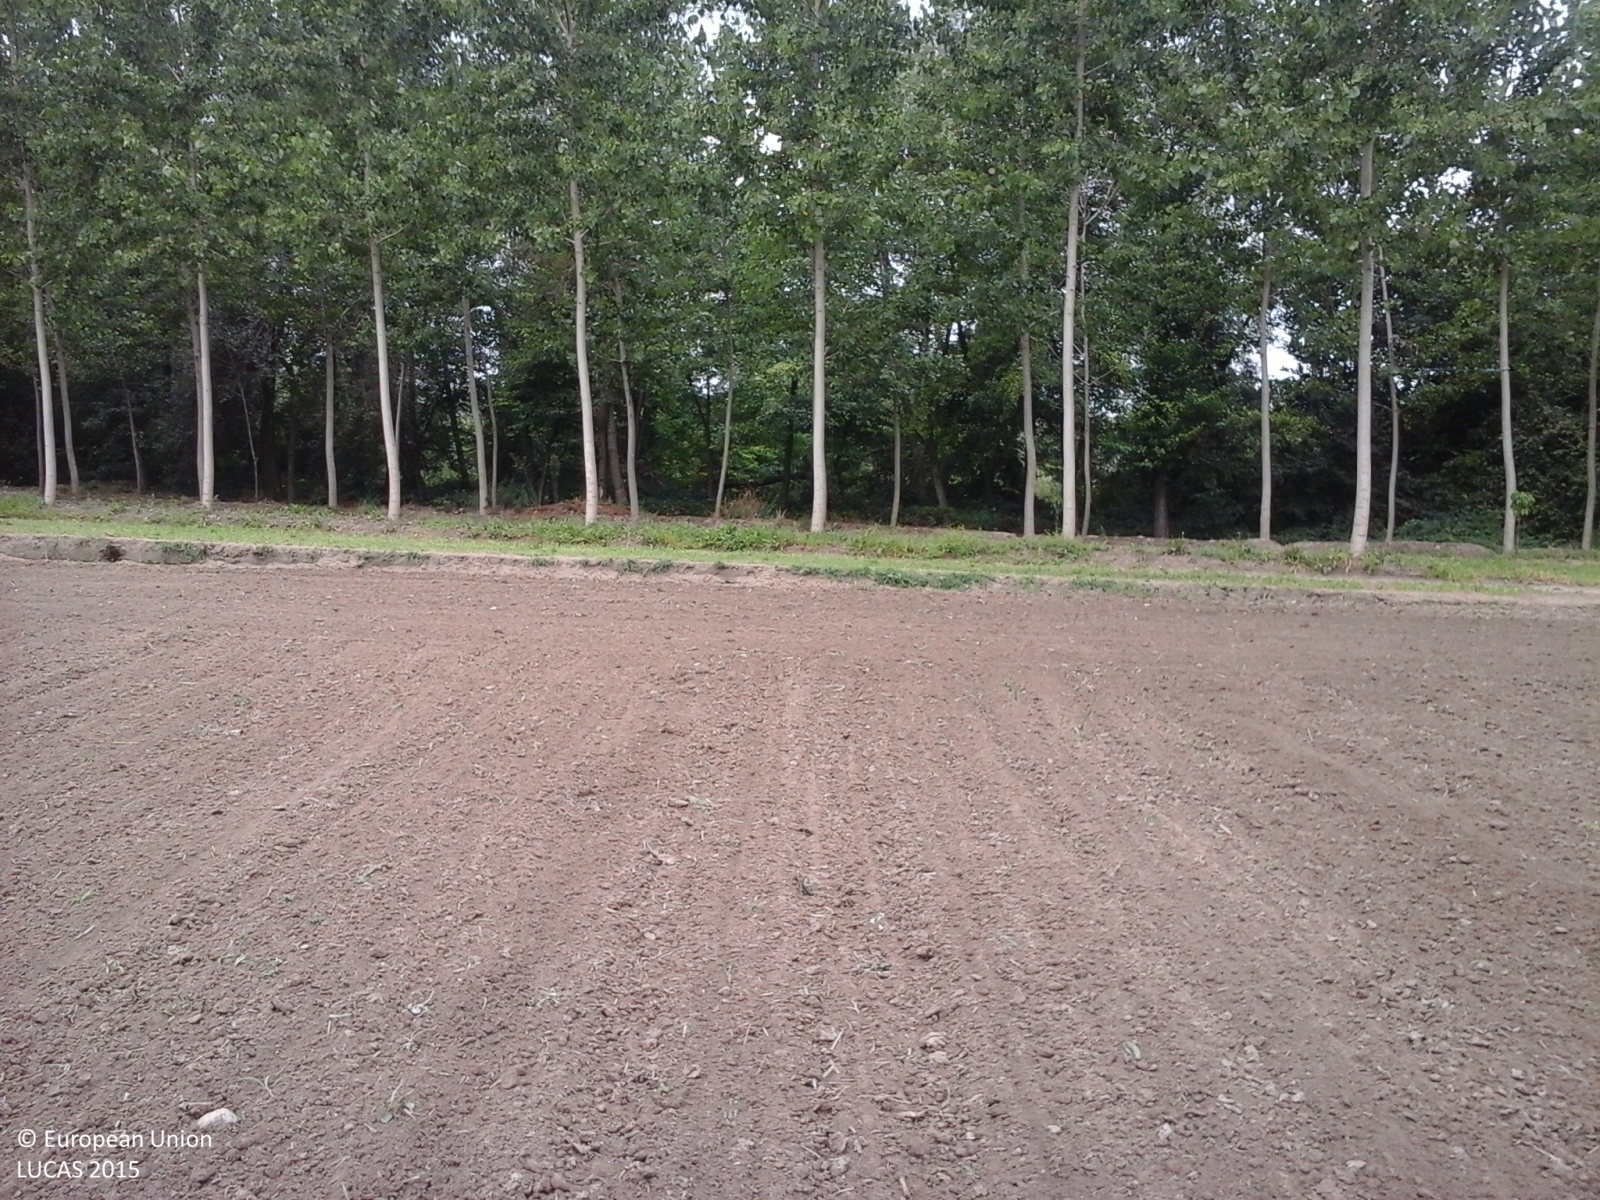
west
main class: Cropland
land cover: Common wheat
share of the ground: < 10 %
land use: Agriculture (excluding fallow land and kitchen gardens)
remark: Harvested field
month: August
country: IT
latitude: 44.6306
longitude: 7.6475
